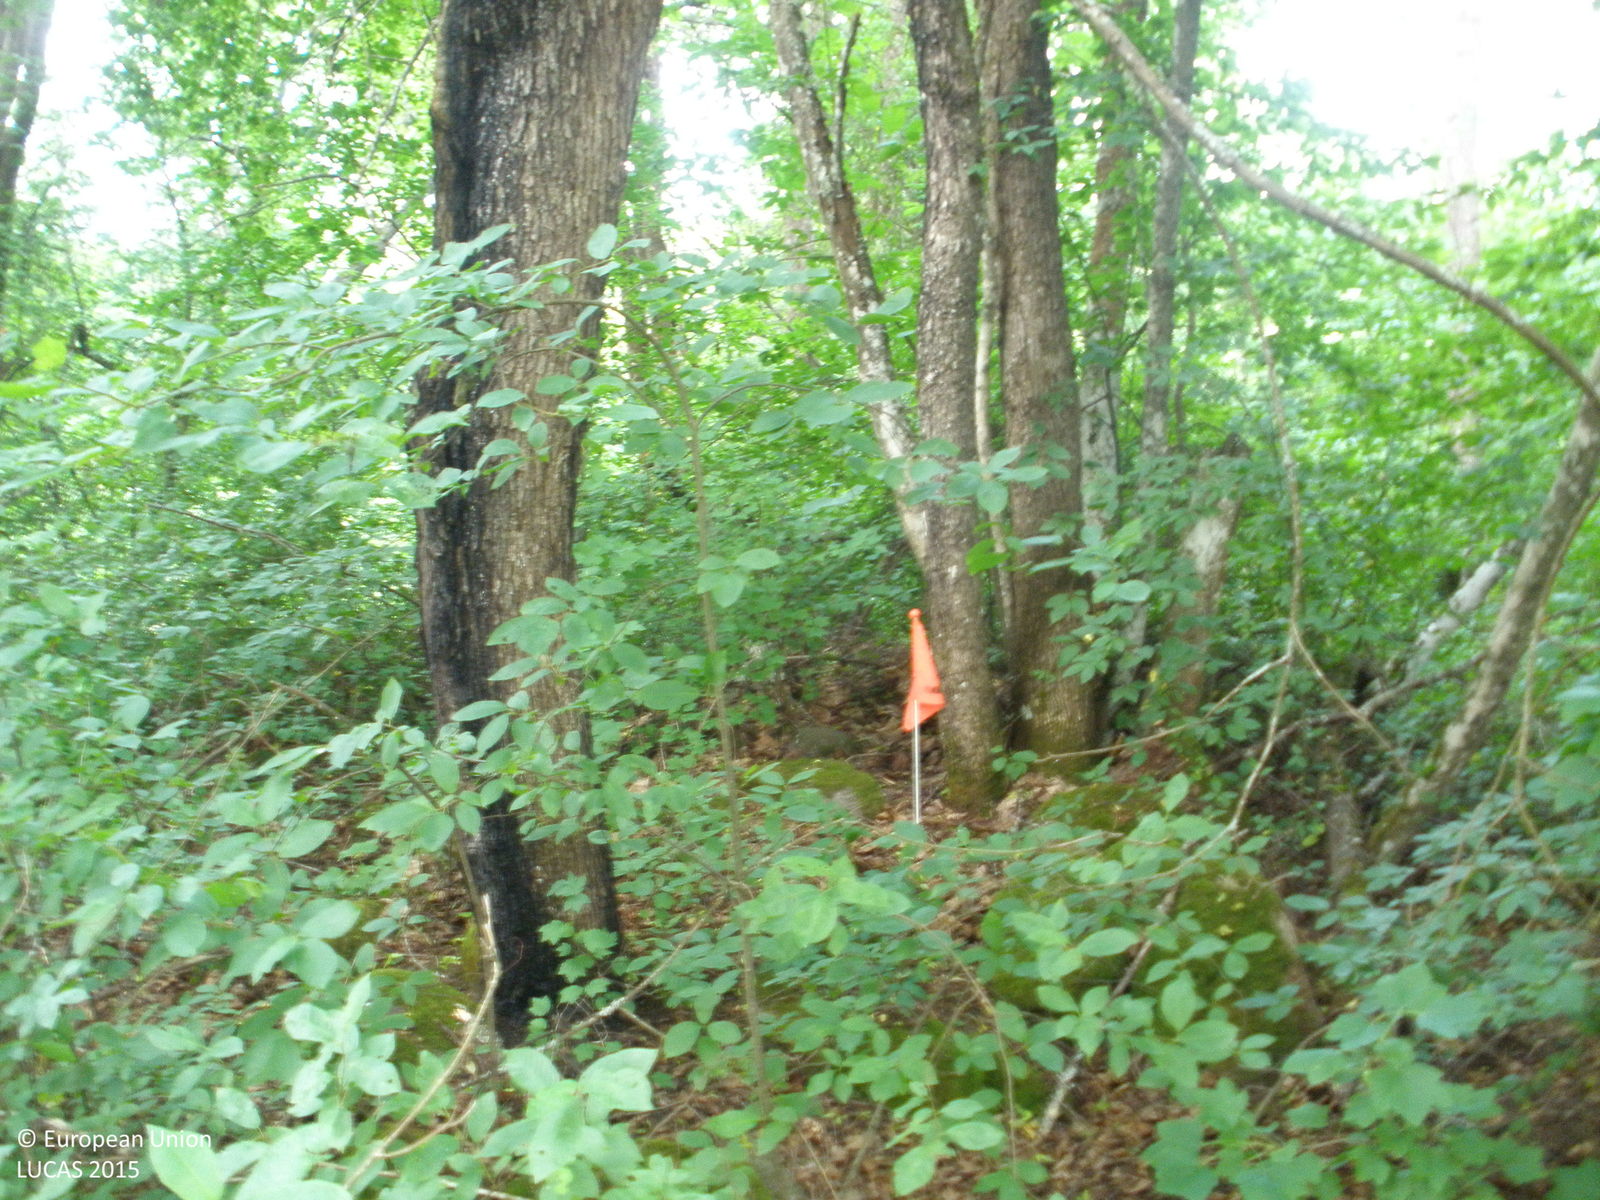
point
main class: Woodland
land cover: Broadleaved woodland
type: non-riverine alder, birch or aspen forest
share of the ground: > 75 %
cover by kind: broadleaved forest trees 85 %, herbaceous plants 10 %, shrubs 5 %
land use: Forestry
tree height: > 5 m
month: June
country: FI
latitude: 61.1718
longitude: 24.6616
